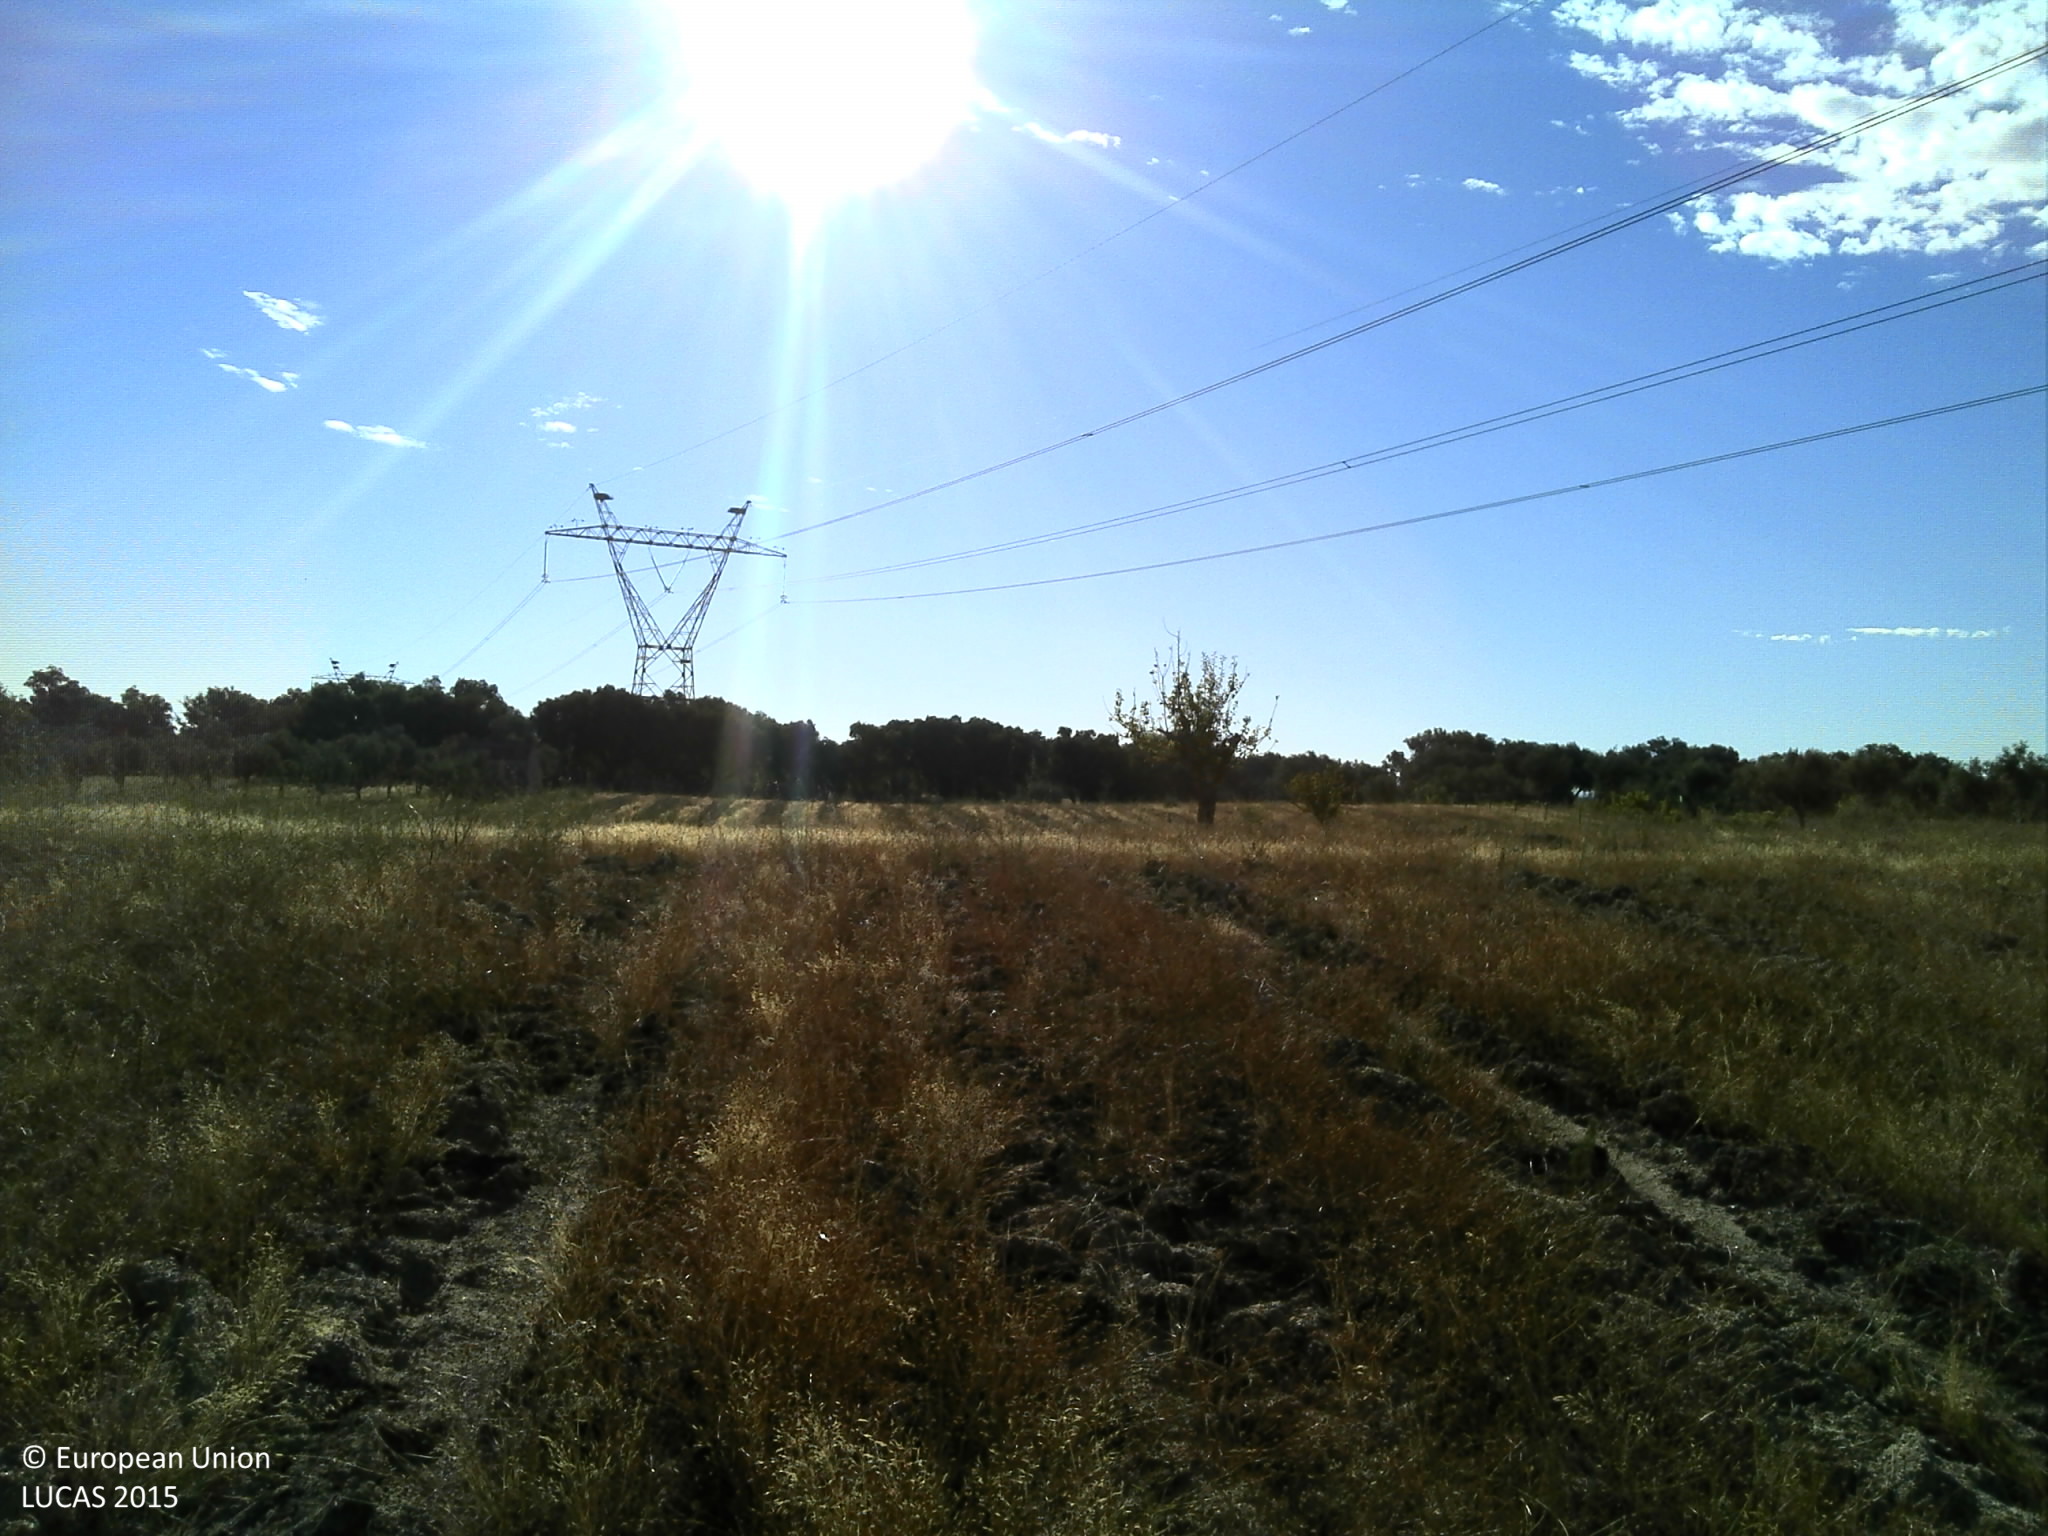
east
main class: Grassland
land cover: Grassland with sparse tree/shrub cover
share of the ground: < 10 %
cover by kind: herbaceous plants 60 %, unconsolidated bare surface 35 %, coniferous forest trees 5 %
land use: Forestry
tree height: < 5 m
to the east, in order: Grassland with sparse tree/shrub cover; Electric lines; Grassland with sparse tree/shrub cover; Fences; Dry stone walls; Grass margins; Tracks; Shruby margins; Dry stone walls; Shruby margins; Broadleaved woodland; Grassland without tree/shrub cover; Broadleaved woodland
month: August
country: PT
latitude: 39.5257
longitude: -7.7236
